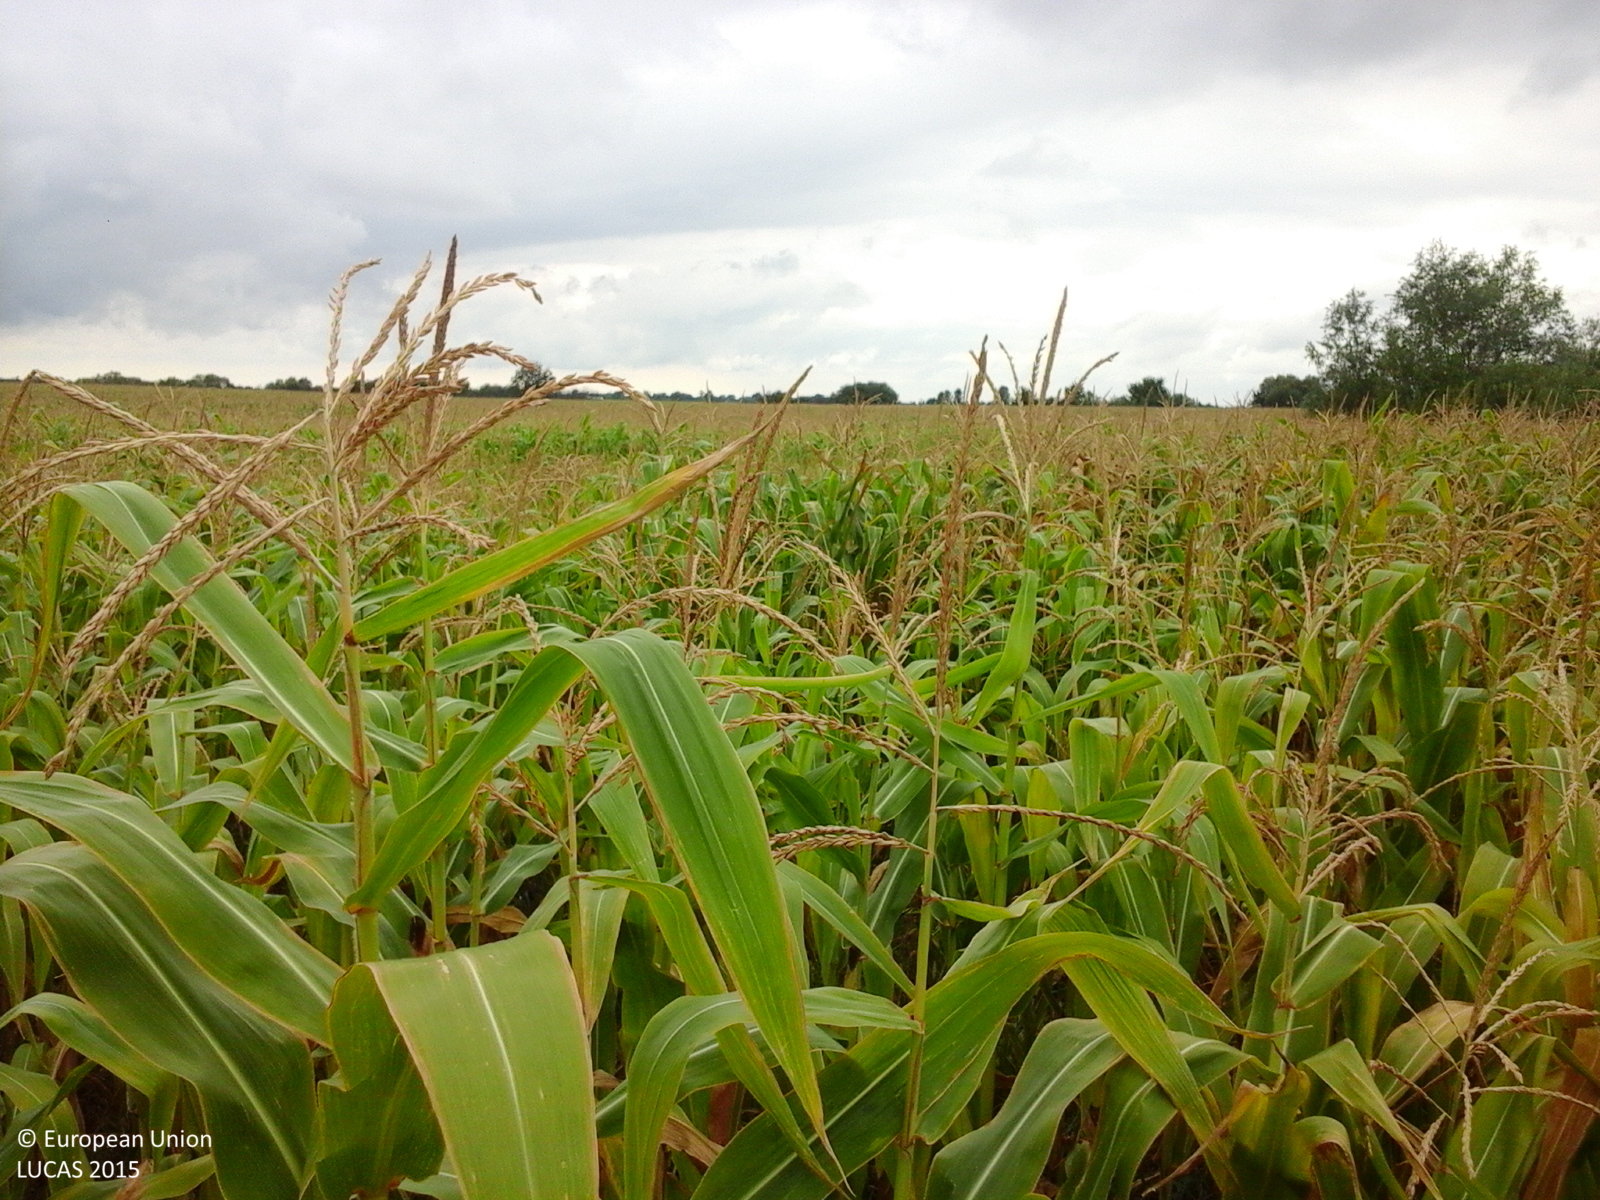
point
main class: Cropland
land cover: Maize
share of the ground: > 75 %
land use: Agriculture (excluding fallow land and kitchen gardens)
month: August
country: RO
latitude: 45.7361
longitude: 21.4321
